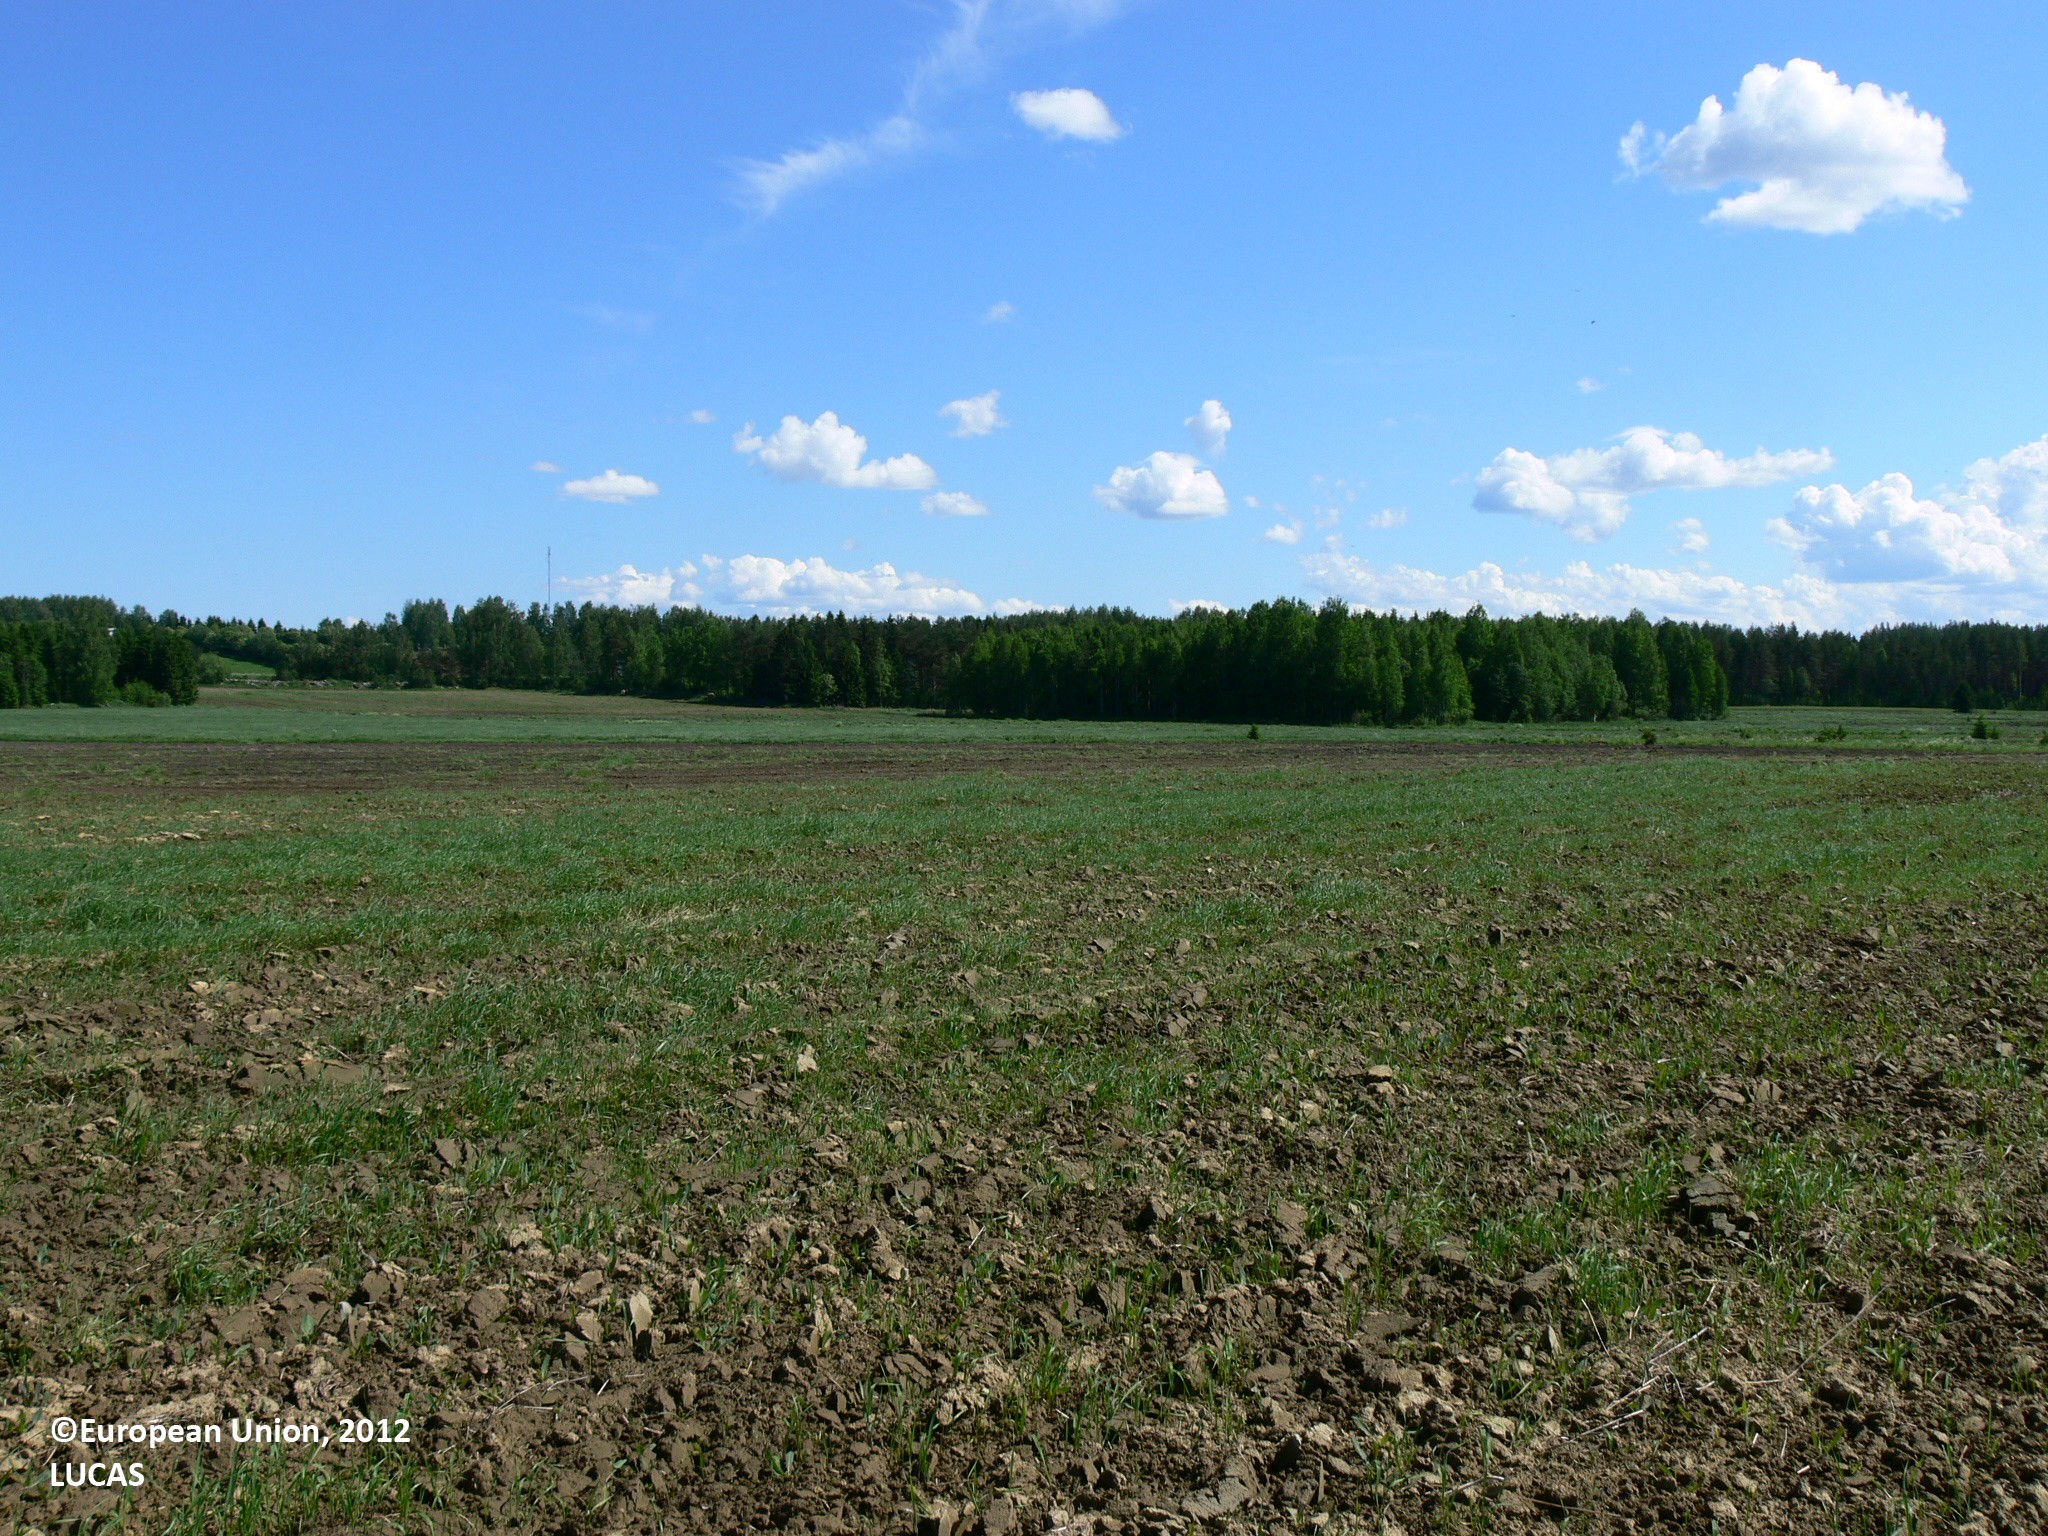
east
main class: Grassland
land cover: Spontaneously vegetated surfaces
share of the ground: < 10 %
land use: Fallow land
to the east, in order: Spontaneously vegetated surfaces; Other bare soil; Grass margins; Ditches and canals; Grass margins; Temporary grasslands; Grass margins; Tracks; Grass margins; Spontaneously vegetated surfaces
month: June
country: FI
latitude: 62.3193
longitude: 30.3657
